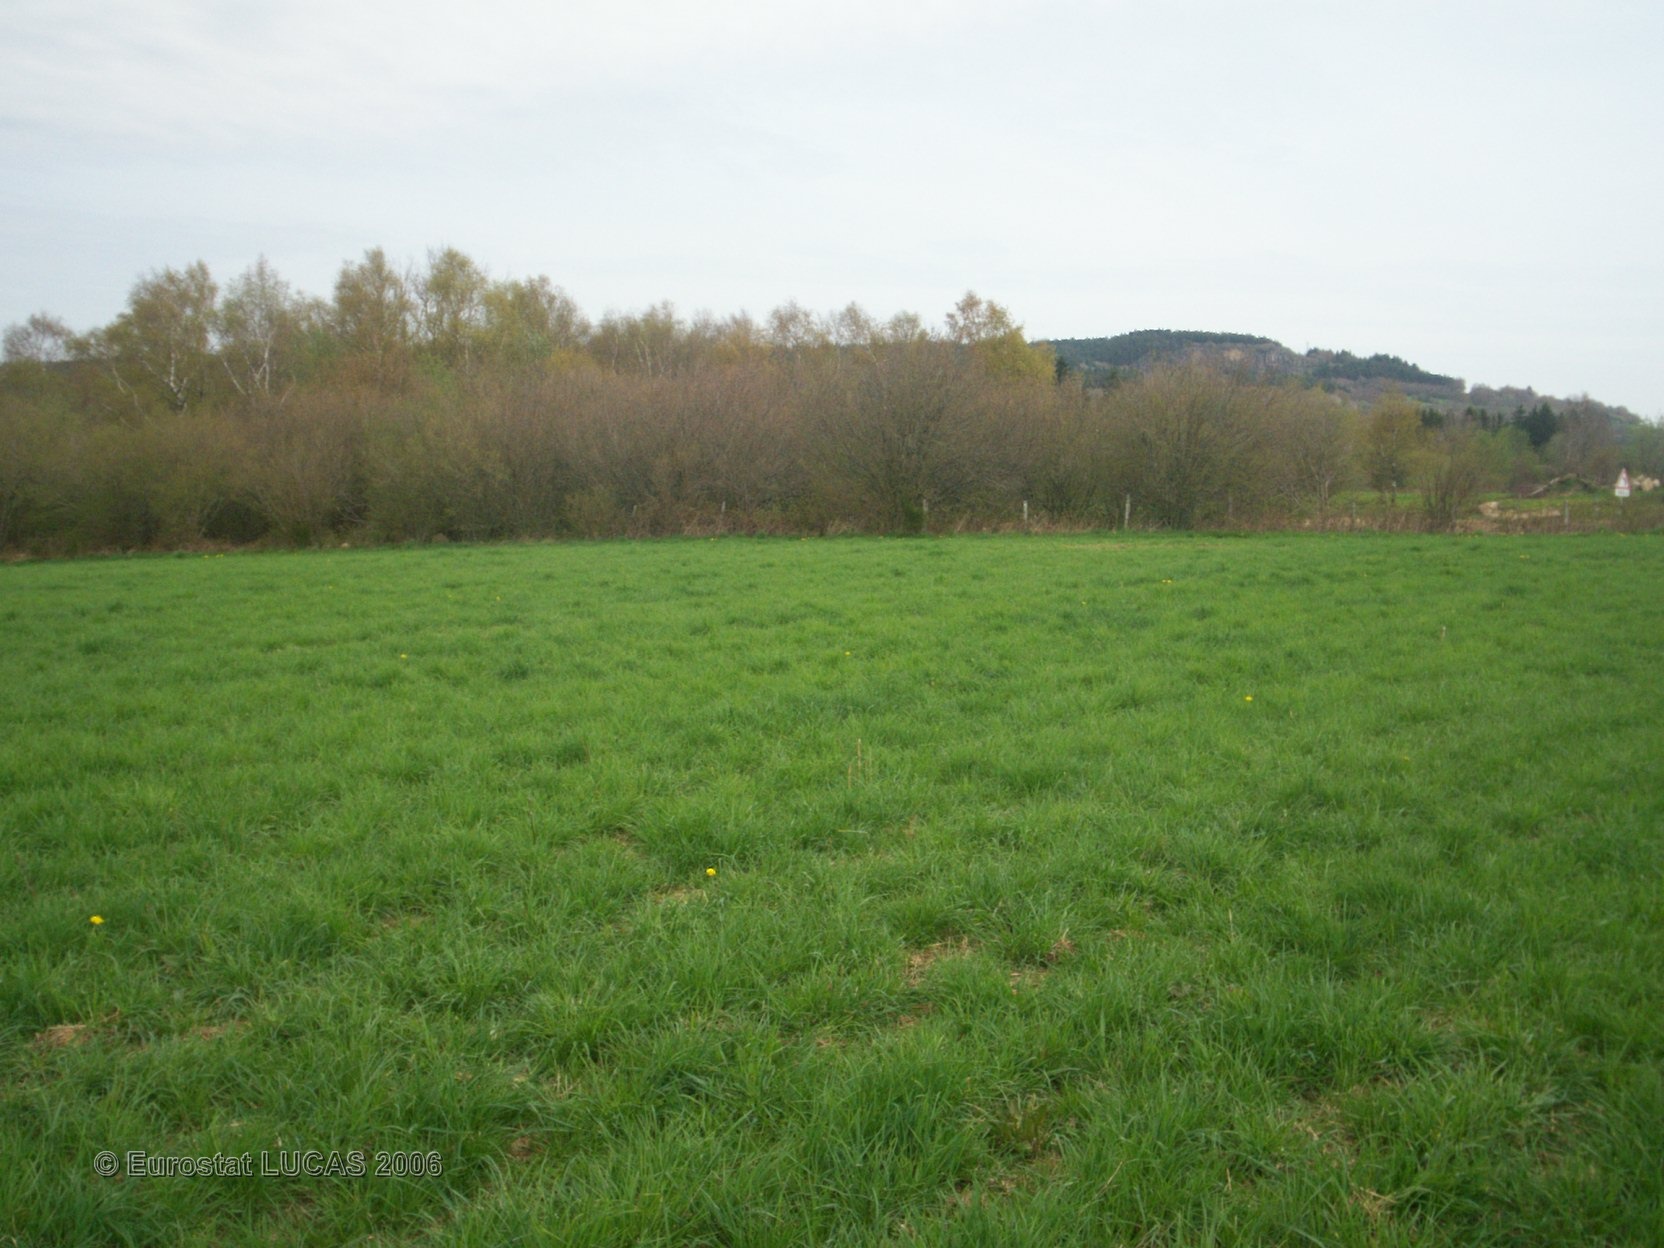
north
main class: Grassland
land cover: Grassland without tree/shrub cover
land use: Agriculture (excluding fallow land and kitchen gardens)
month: May
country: FR
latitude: 45.8997
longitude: 2.9226
